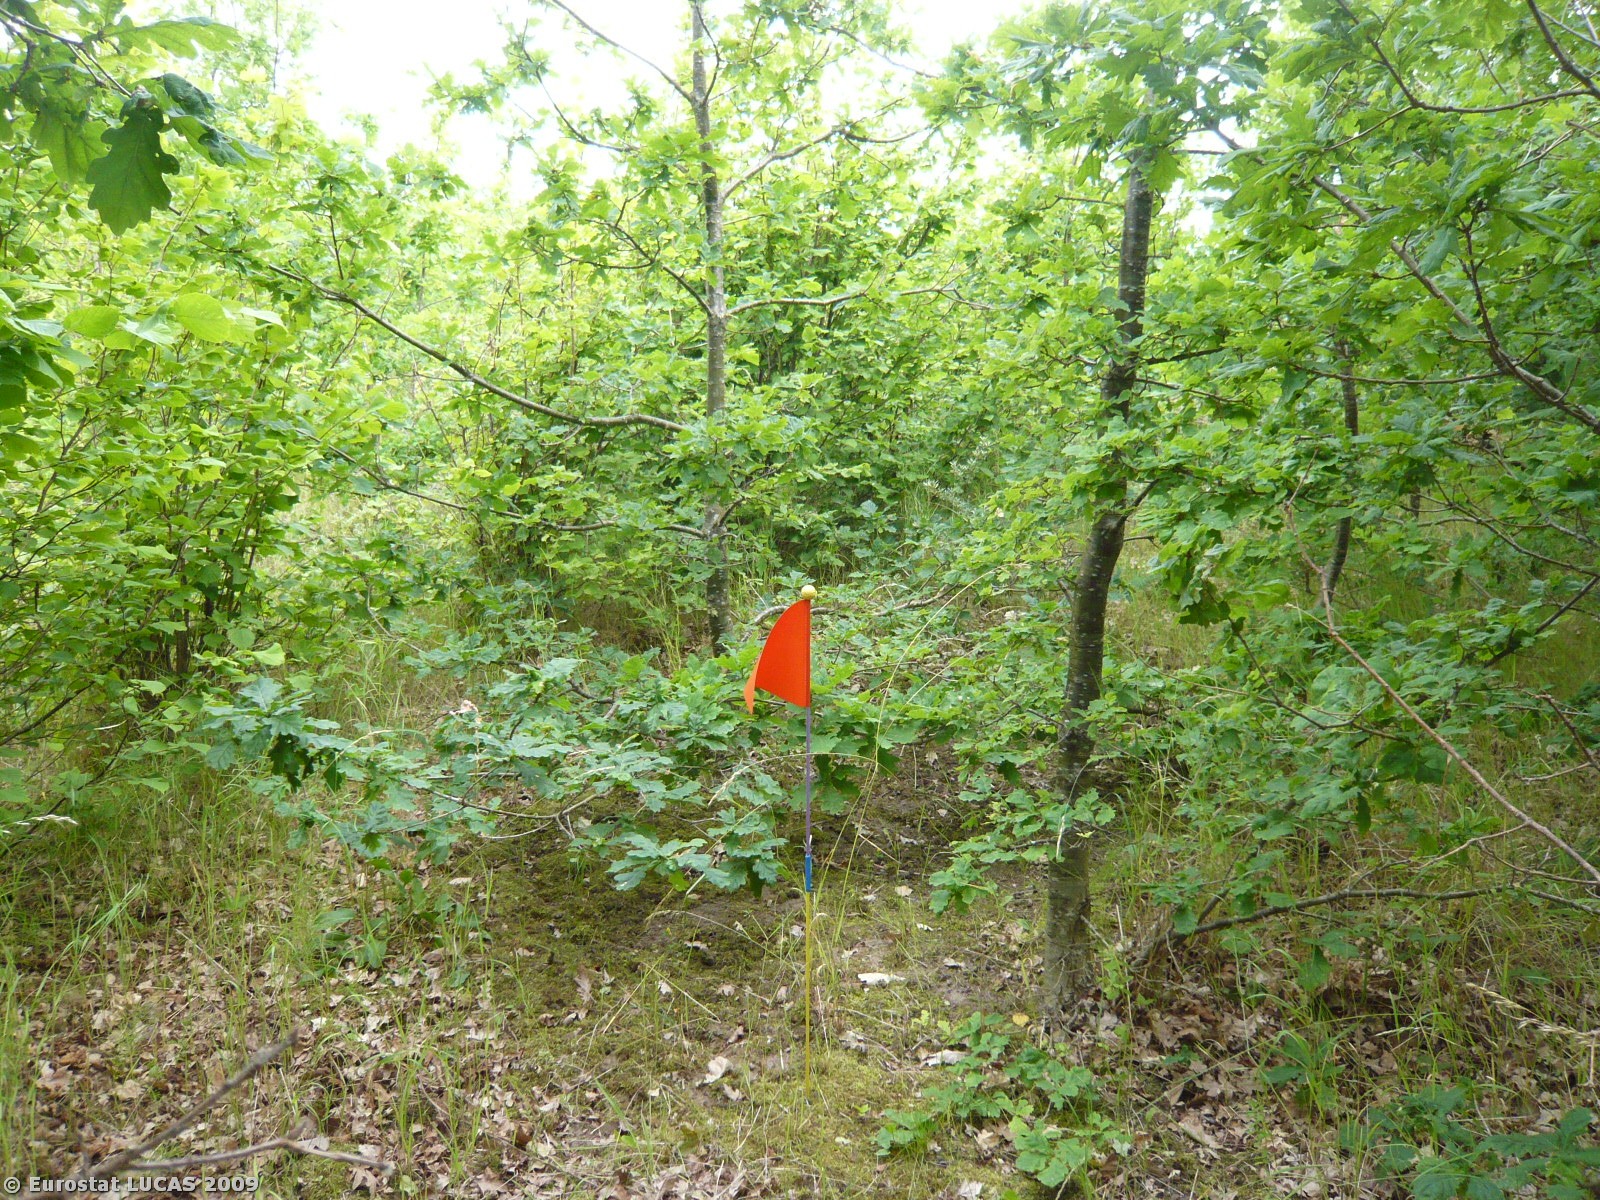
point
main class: Woodland
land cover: Broadleaved woodland
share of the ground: > 75 %
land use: Forestry
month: June
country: DK
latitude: 55.1991
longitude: 10.1413
